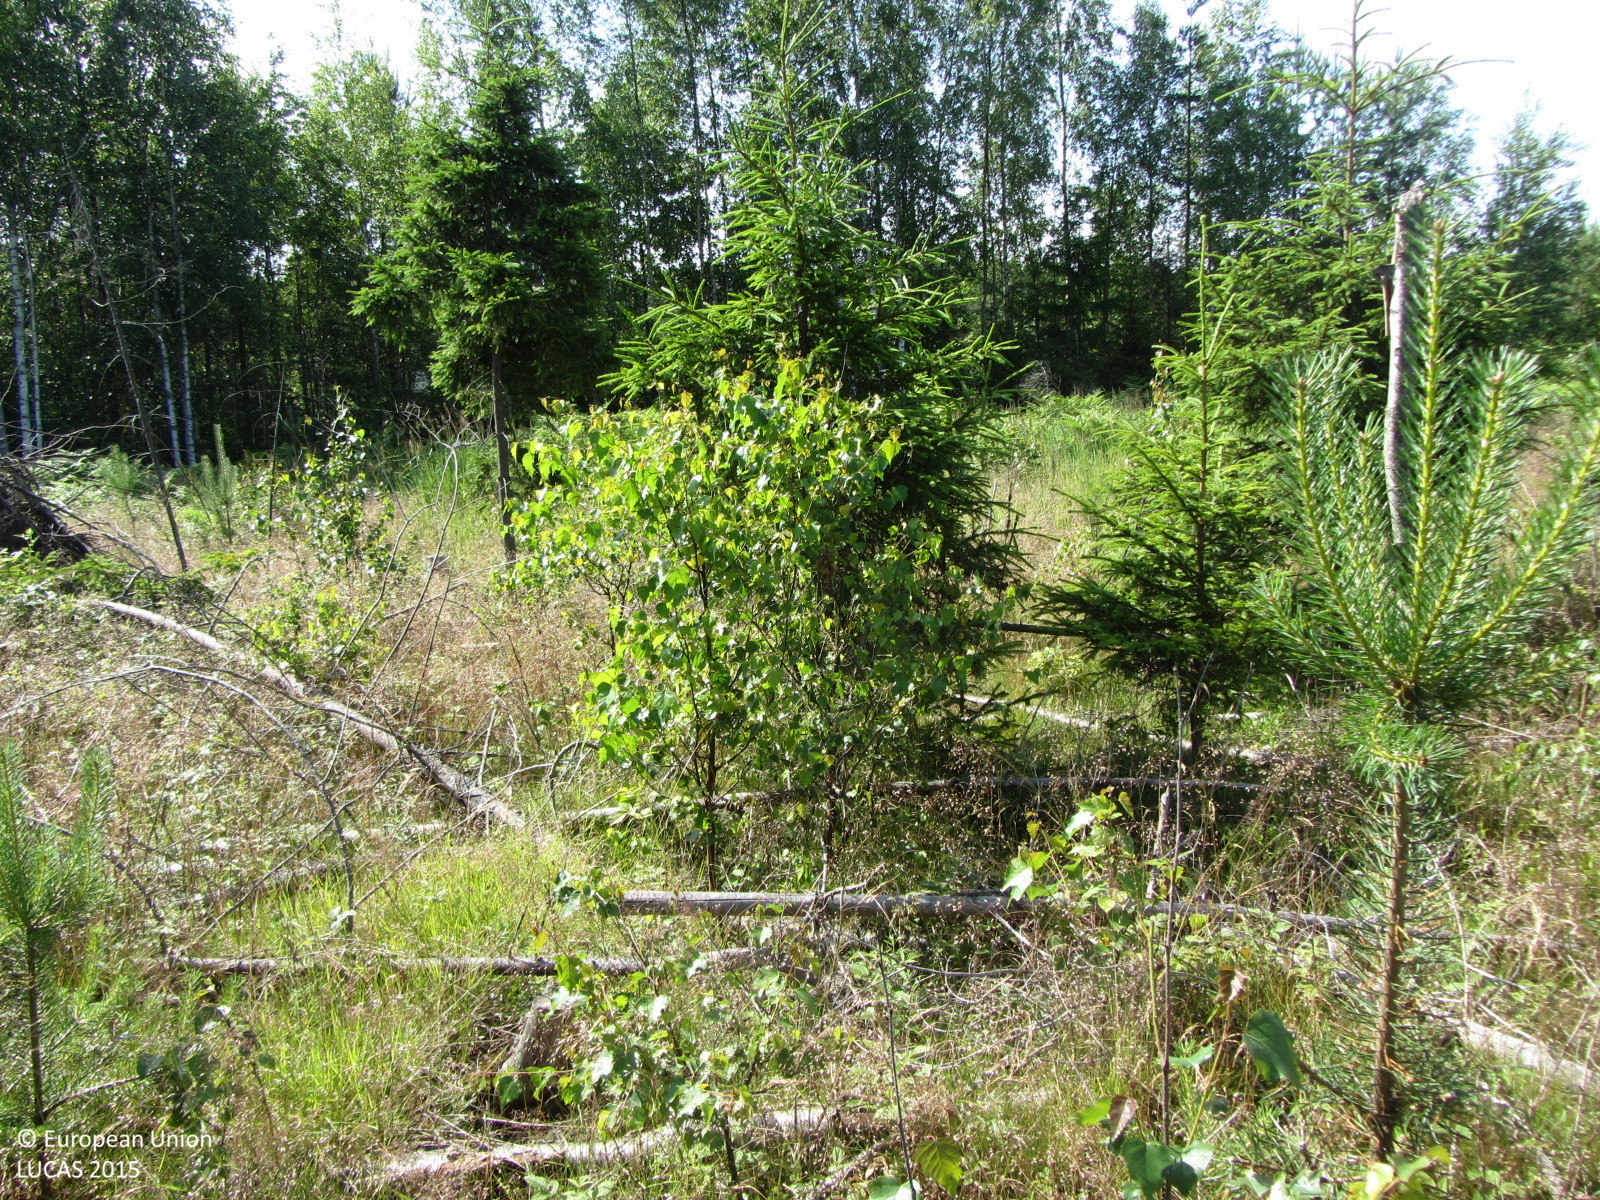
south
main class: Woodland
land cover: Spruce dominated mixed woodland
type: boreal forest
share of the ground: 25 - 50 %
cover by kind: herbaceous plants 60 %, broadleaved forest trees 15 %, shrubs 15 %, coniferous forest trees 10 %
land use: Forestry
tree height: < 5 m
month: July
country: FI
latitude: 60.0817
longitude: 24.5438
